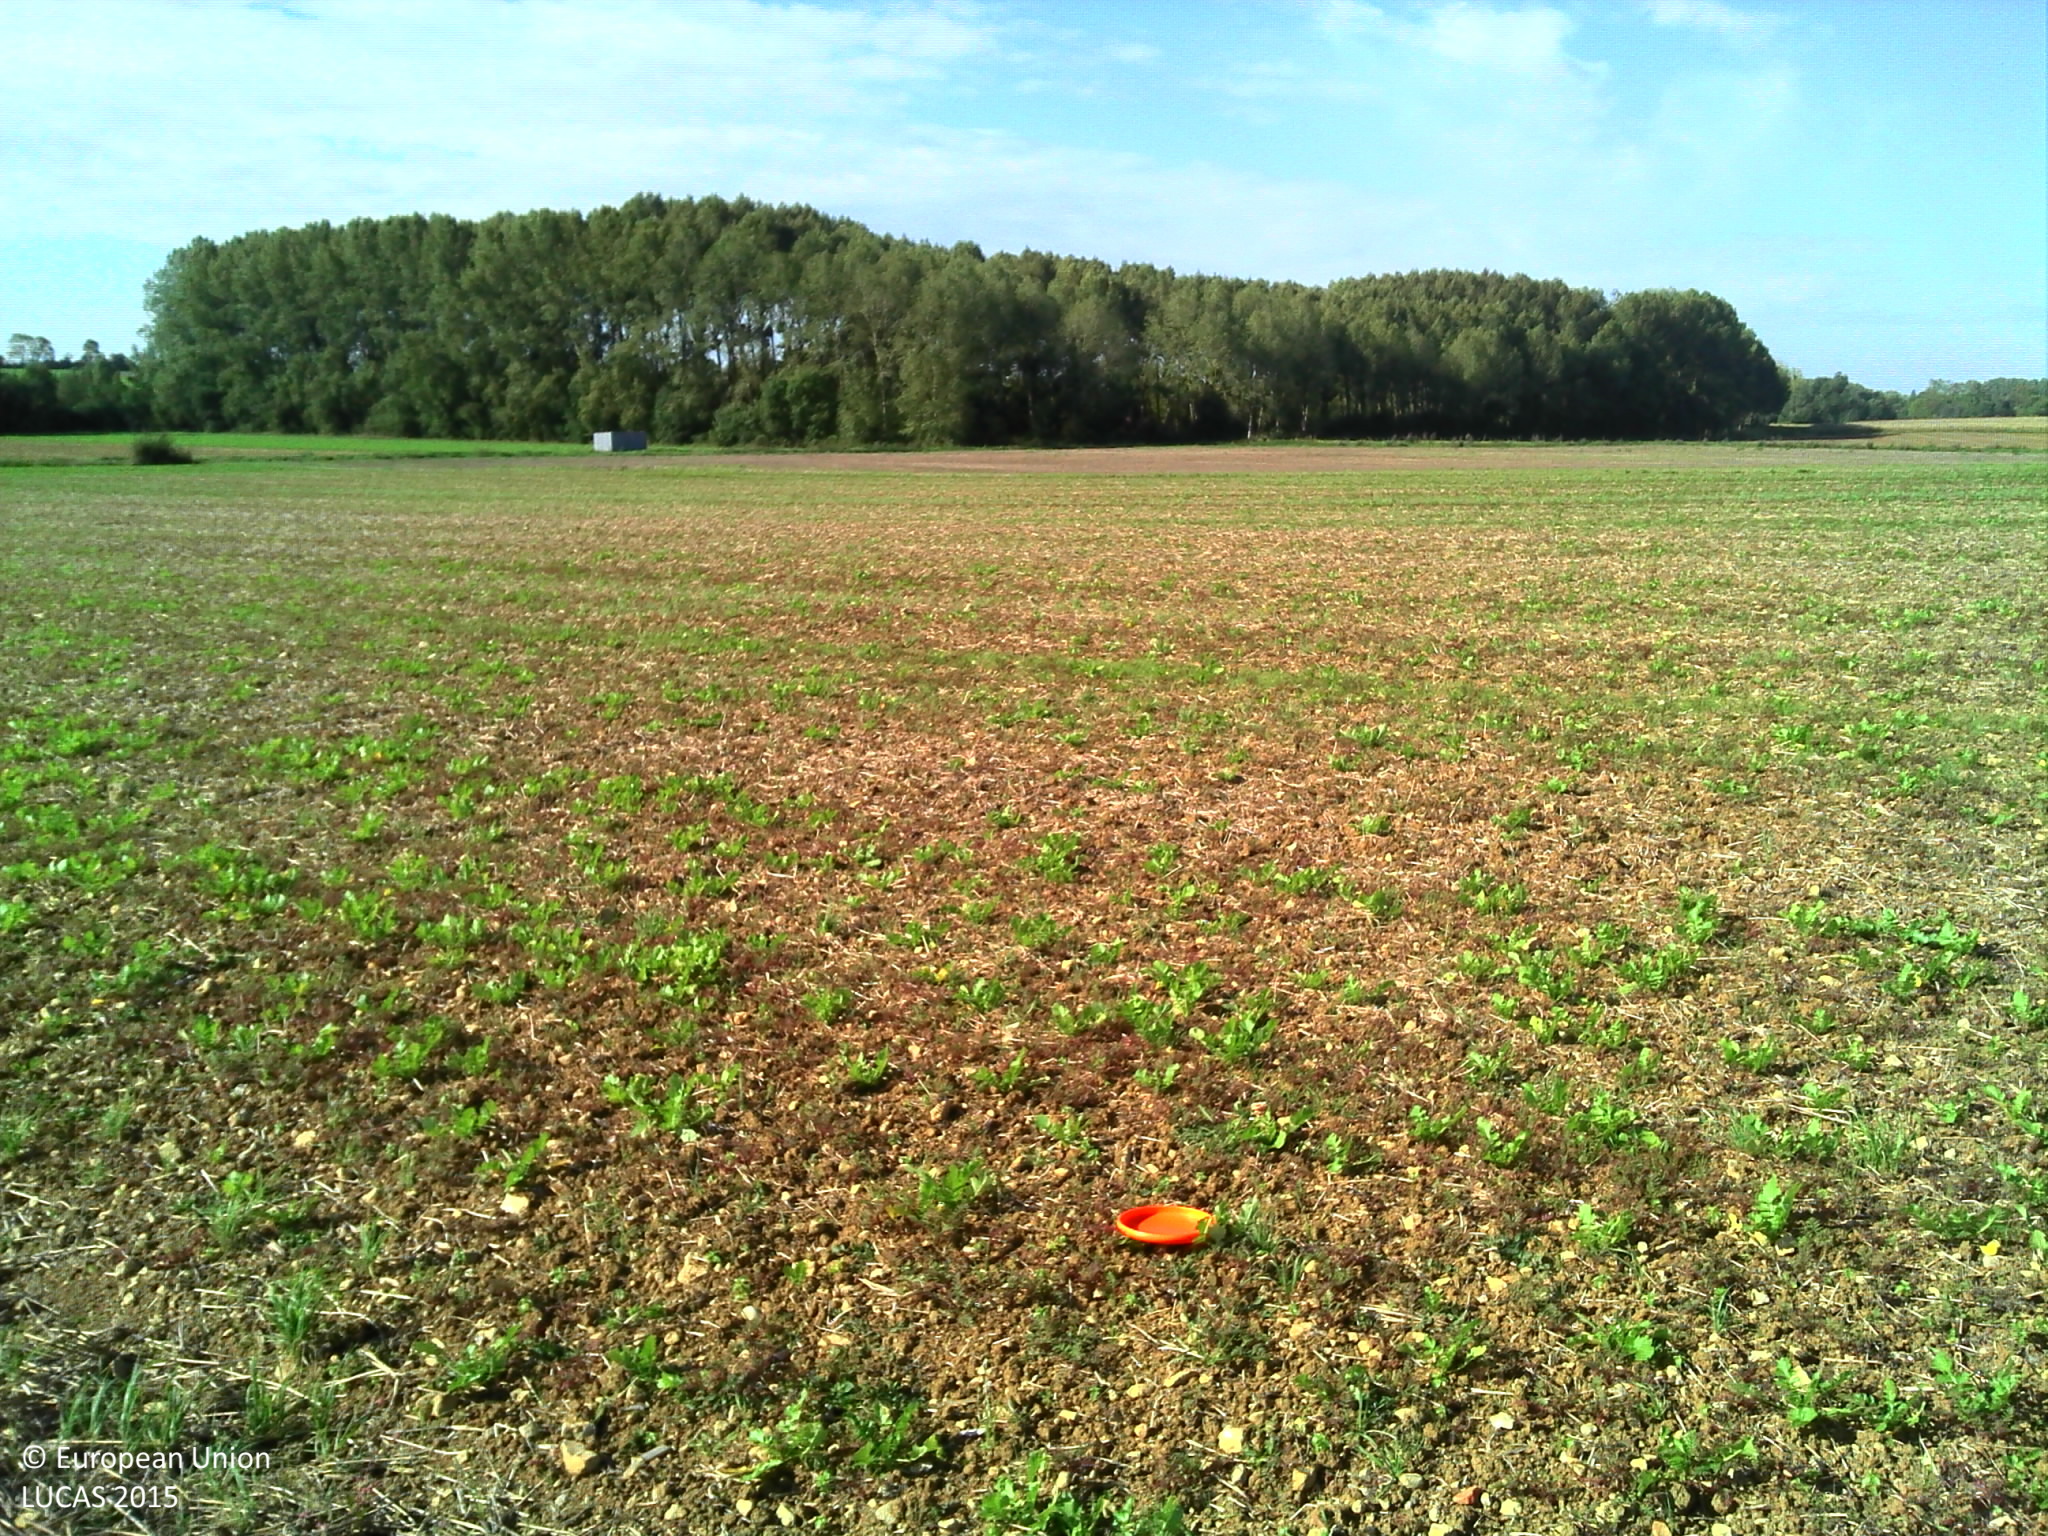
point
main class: Cropland
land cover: Other leguminous and mixtures for fodder
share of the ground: 10 - 25 %
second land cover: Other root crops
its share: 10 - 25 %
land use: Agriculture (excluding fallow land and kitchen gardens)
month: September
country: FR
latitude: 46.5603
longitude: -1.0292
